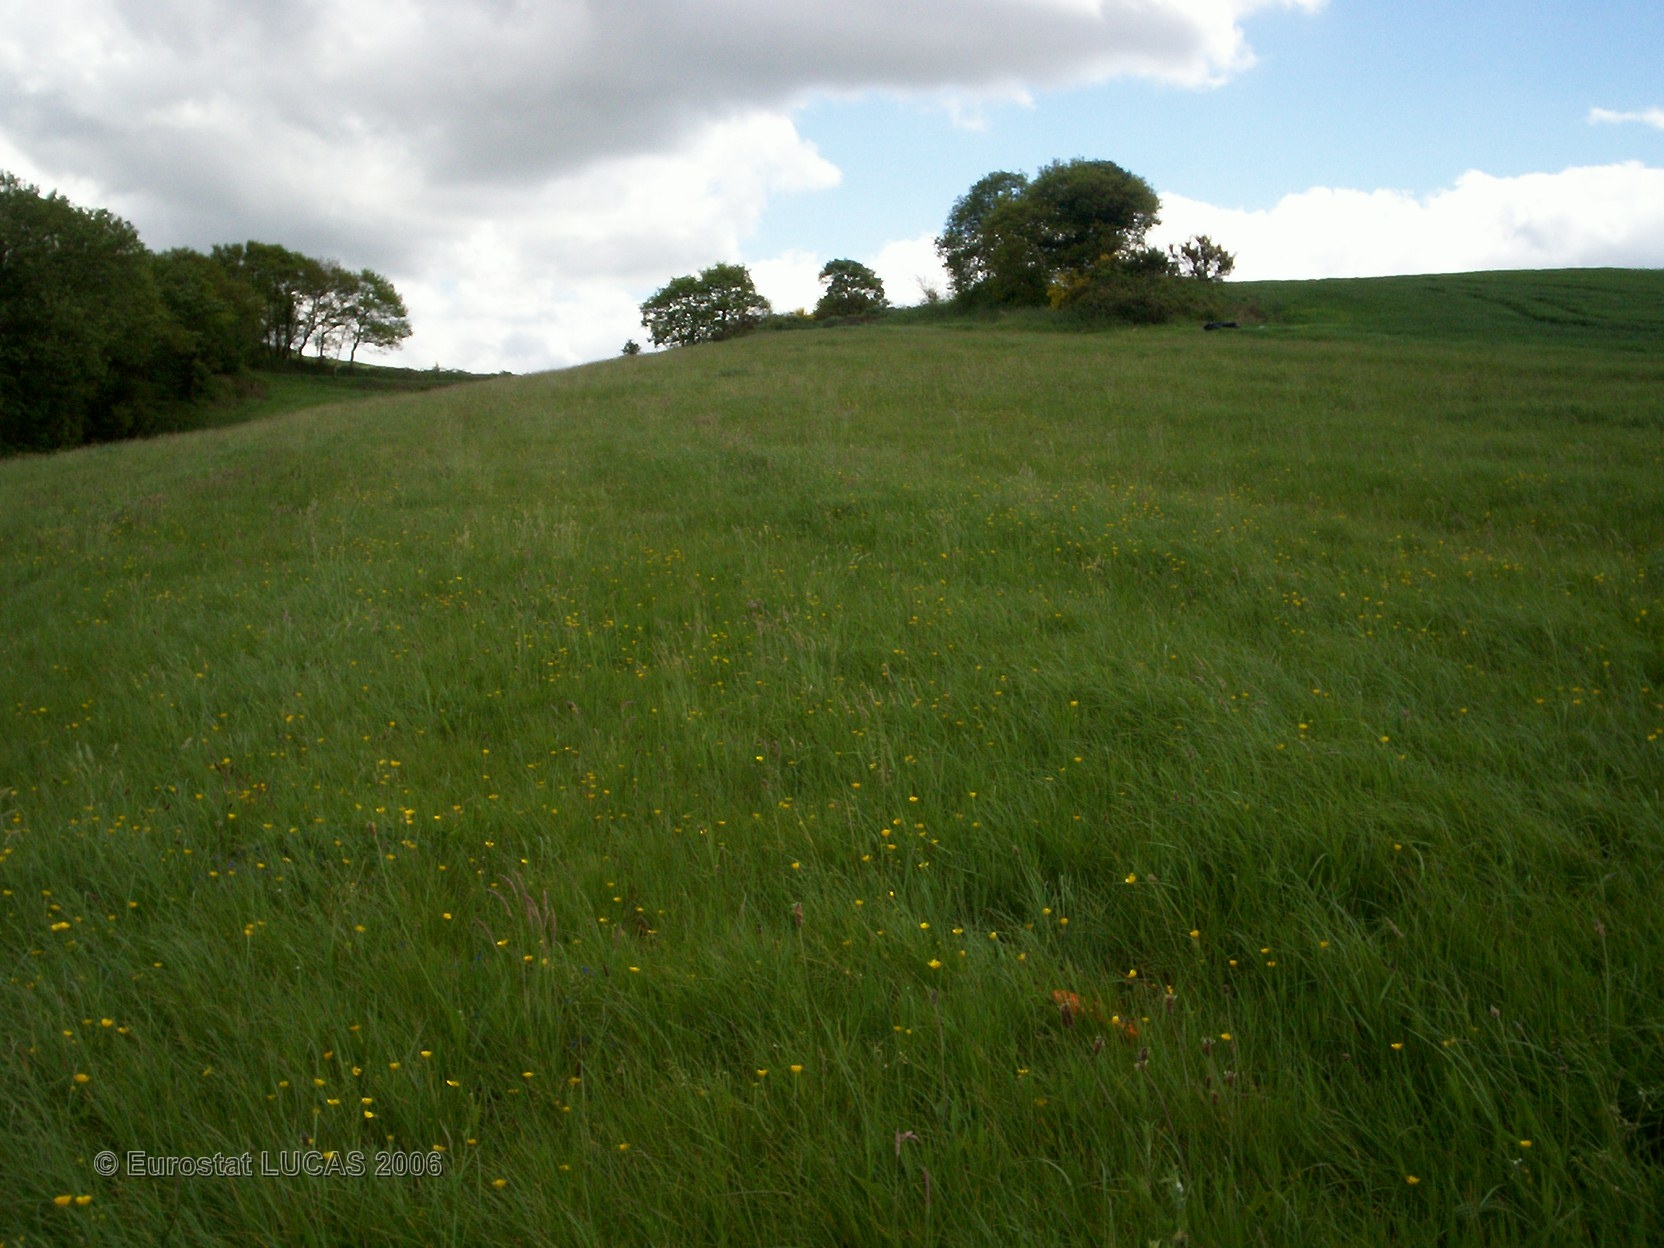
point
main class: Grassland
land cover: Grassland without tree/shrub cover
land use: Agriculture (excluding fallow land and kitchen gardens)
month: May
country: FR
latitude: 48.4125
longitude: -3.0266
